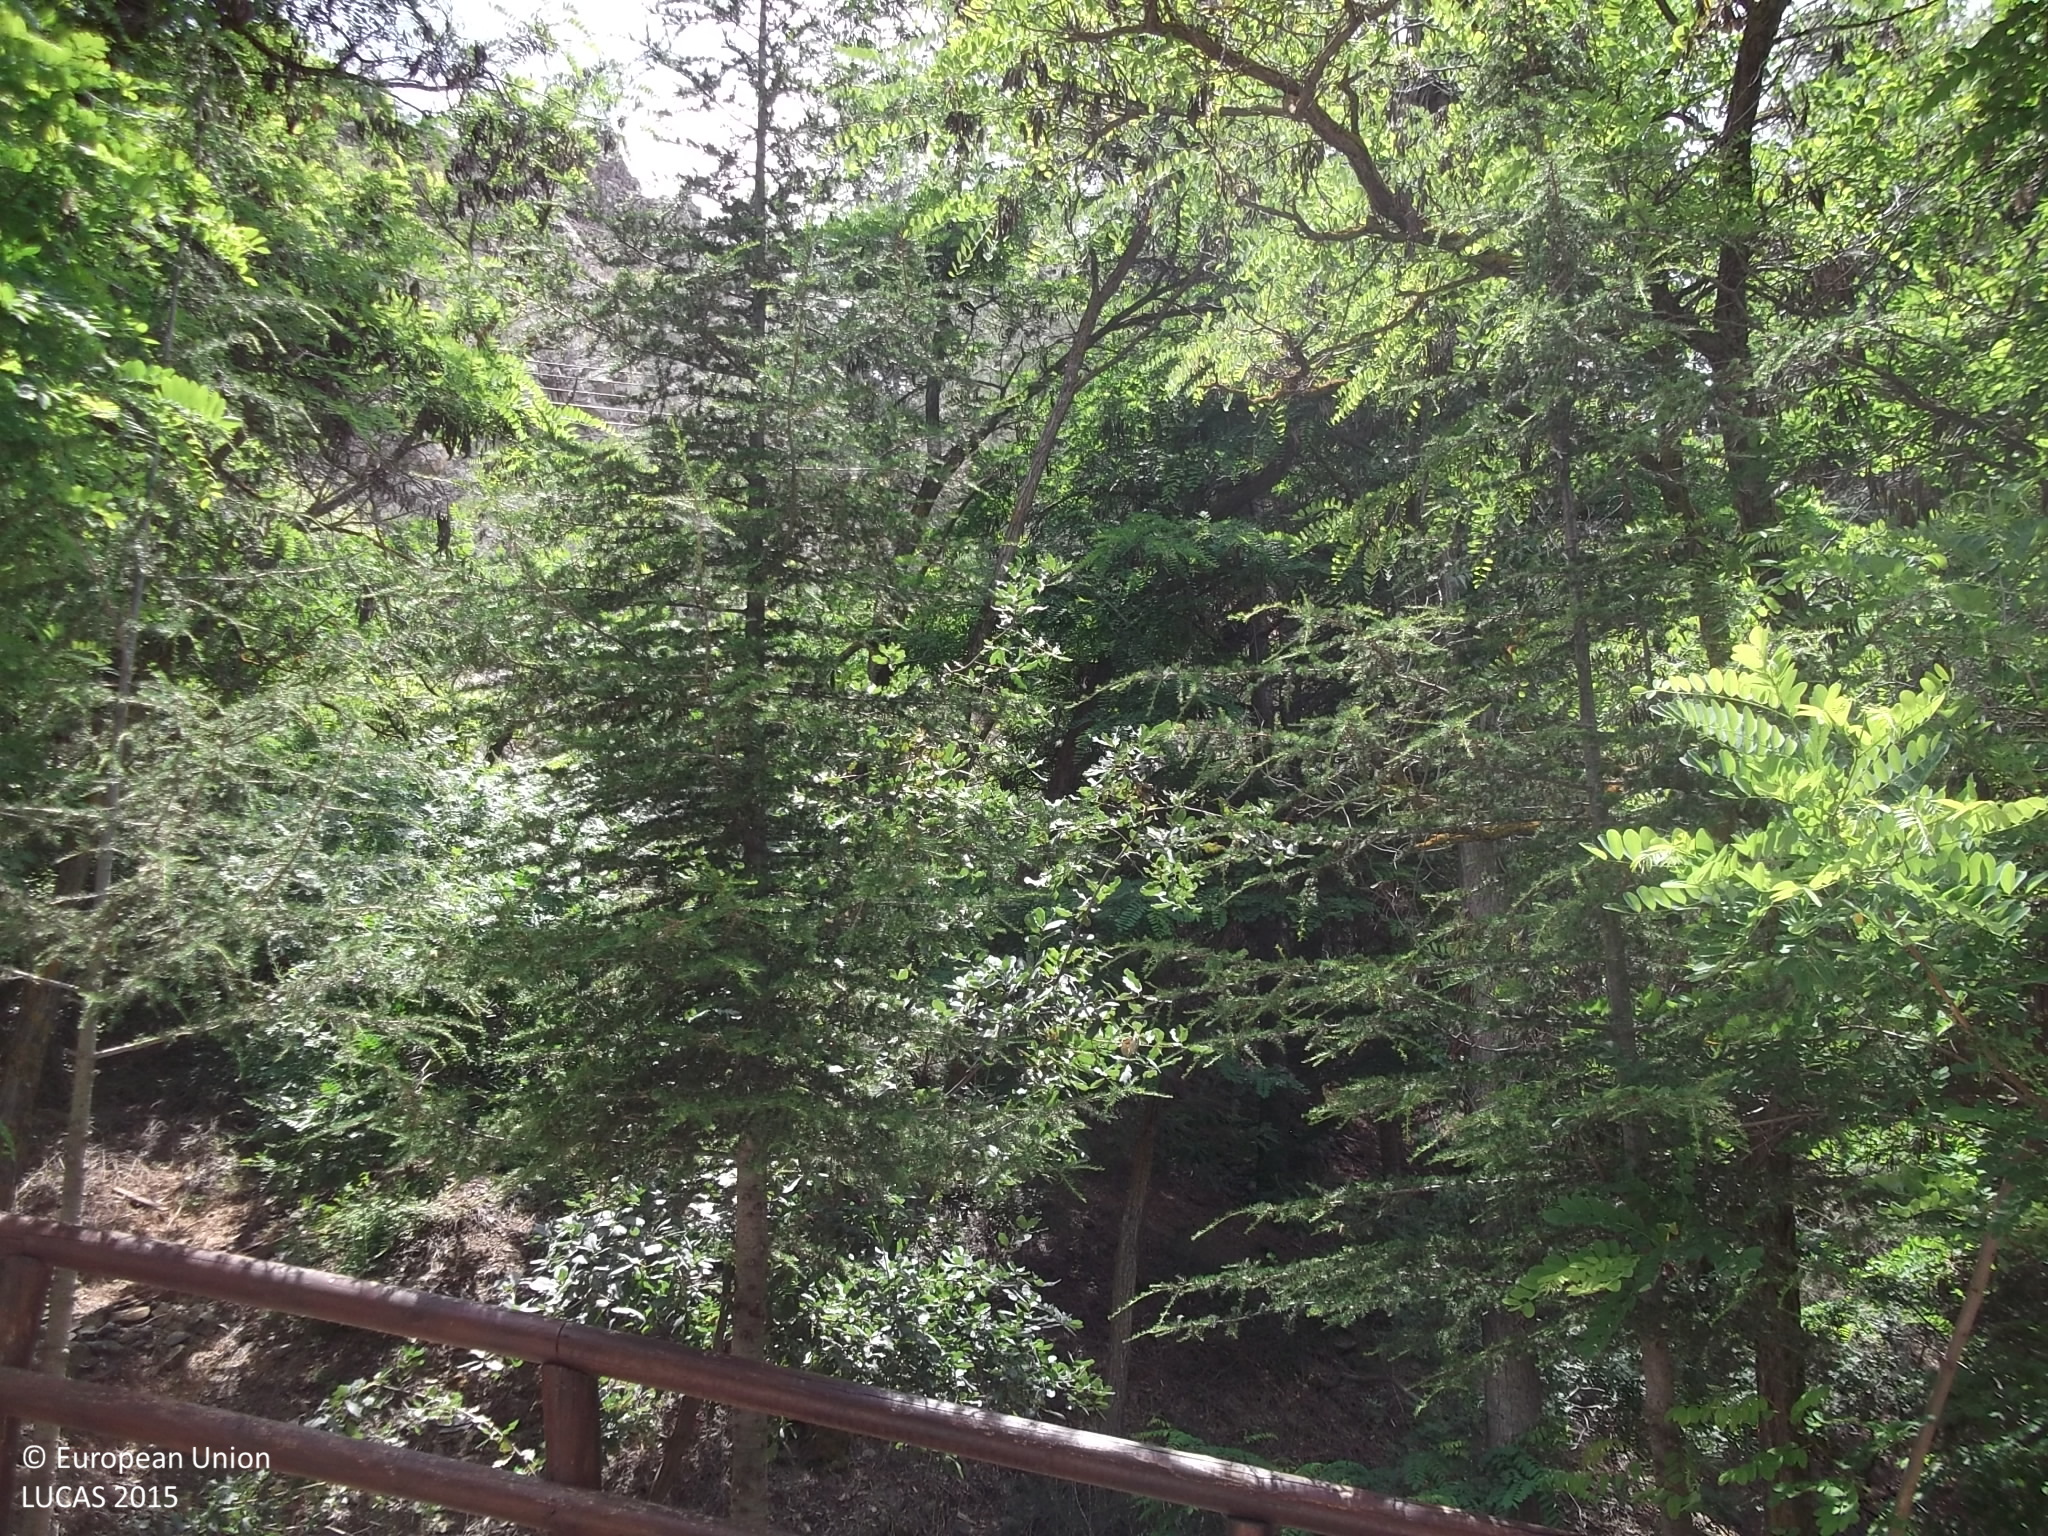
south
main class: Woodland
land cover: Pine dominated coniferous woodland
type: coniferous forest of the mediterranean region
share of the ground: > 75 %
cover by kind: coniferous forest trees 90 %, shrubs 5 %, unconsolidated bare surface 5 %
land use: Semi-natural and natural areas not in use
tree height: > 5 m
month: June
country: CY
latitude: 34.9264
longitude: 32.9956
